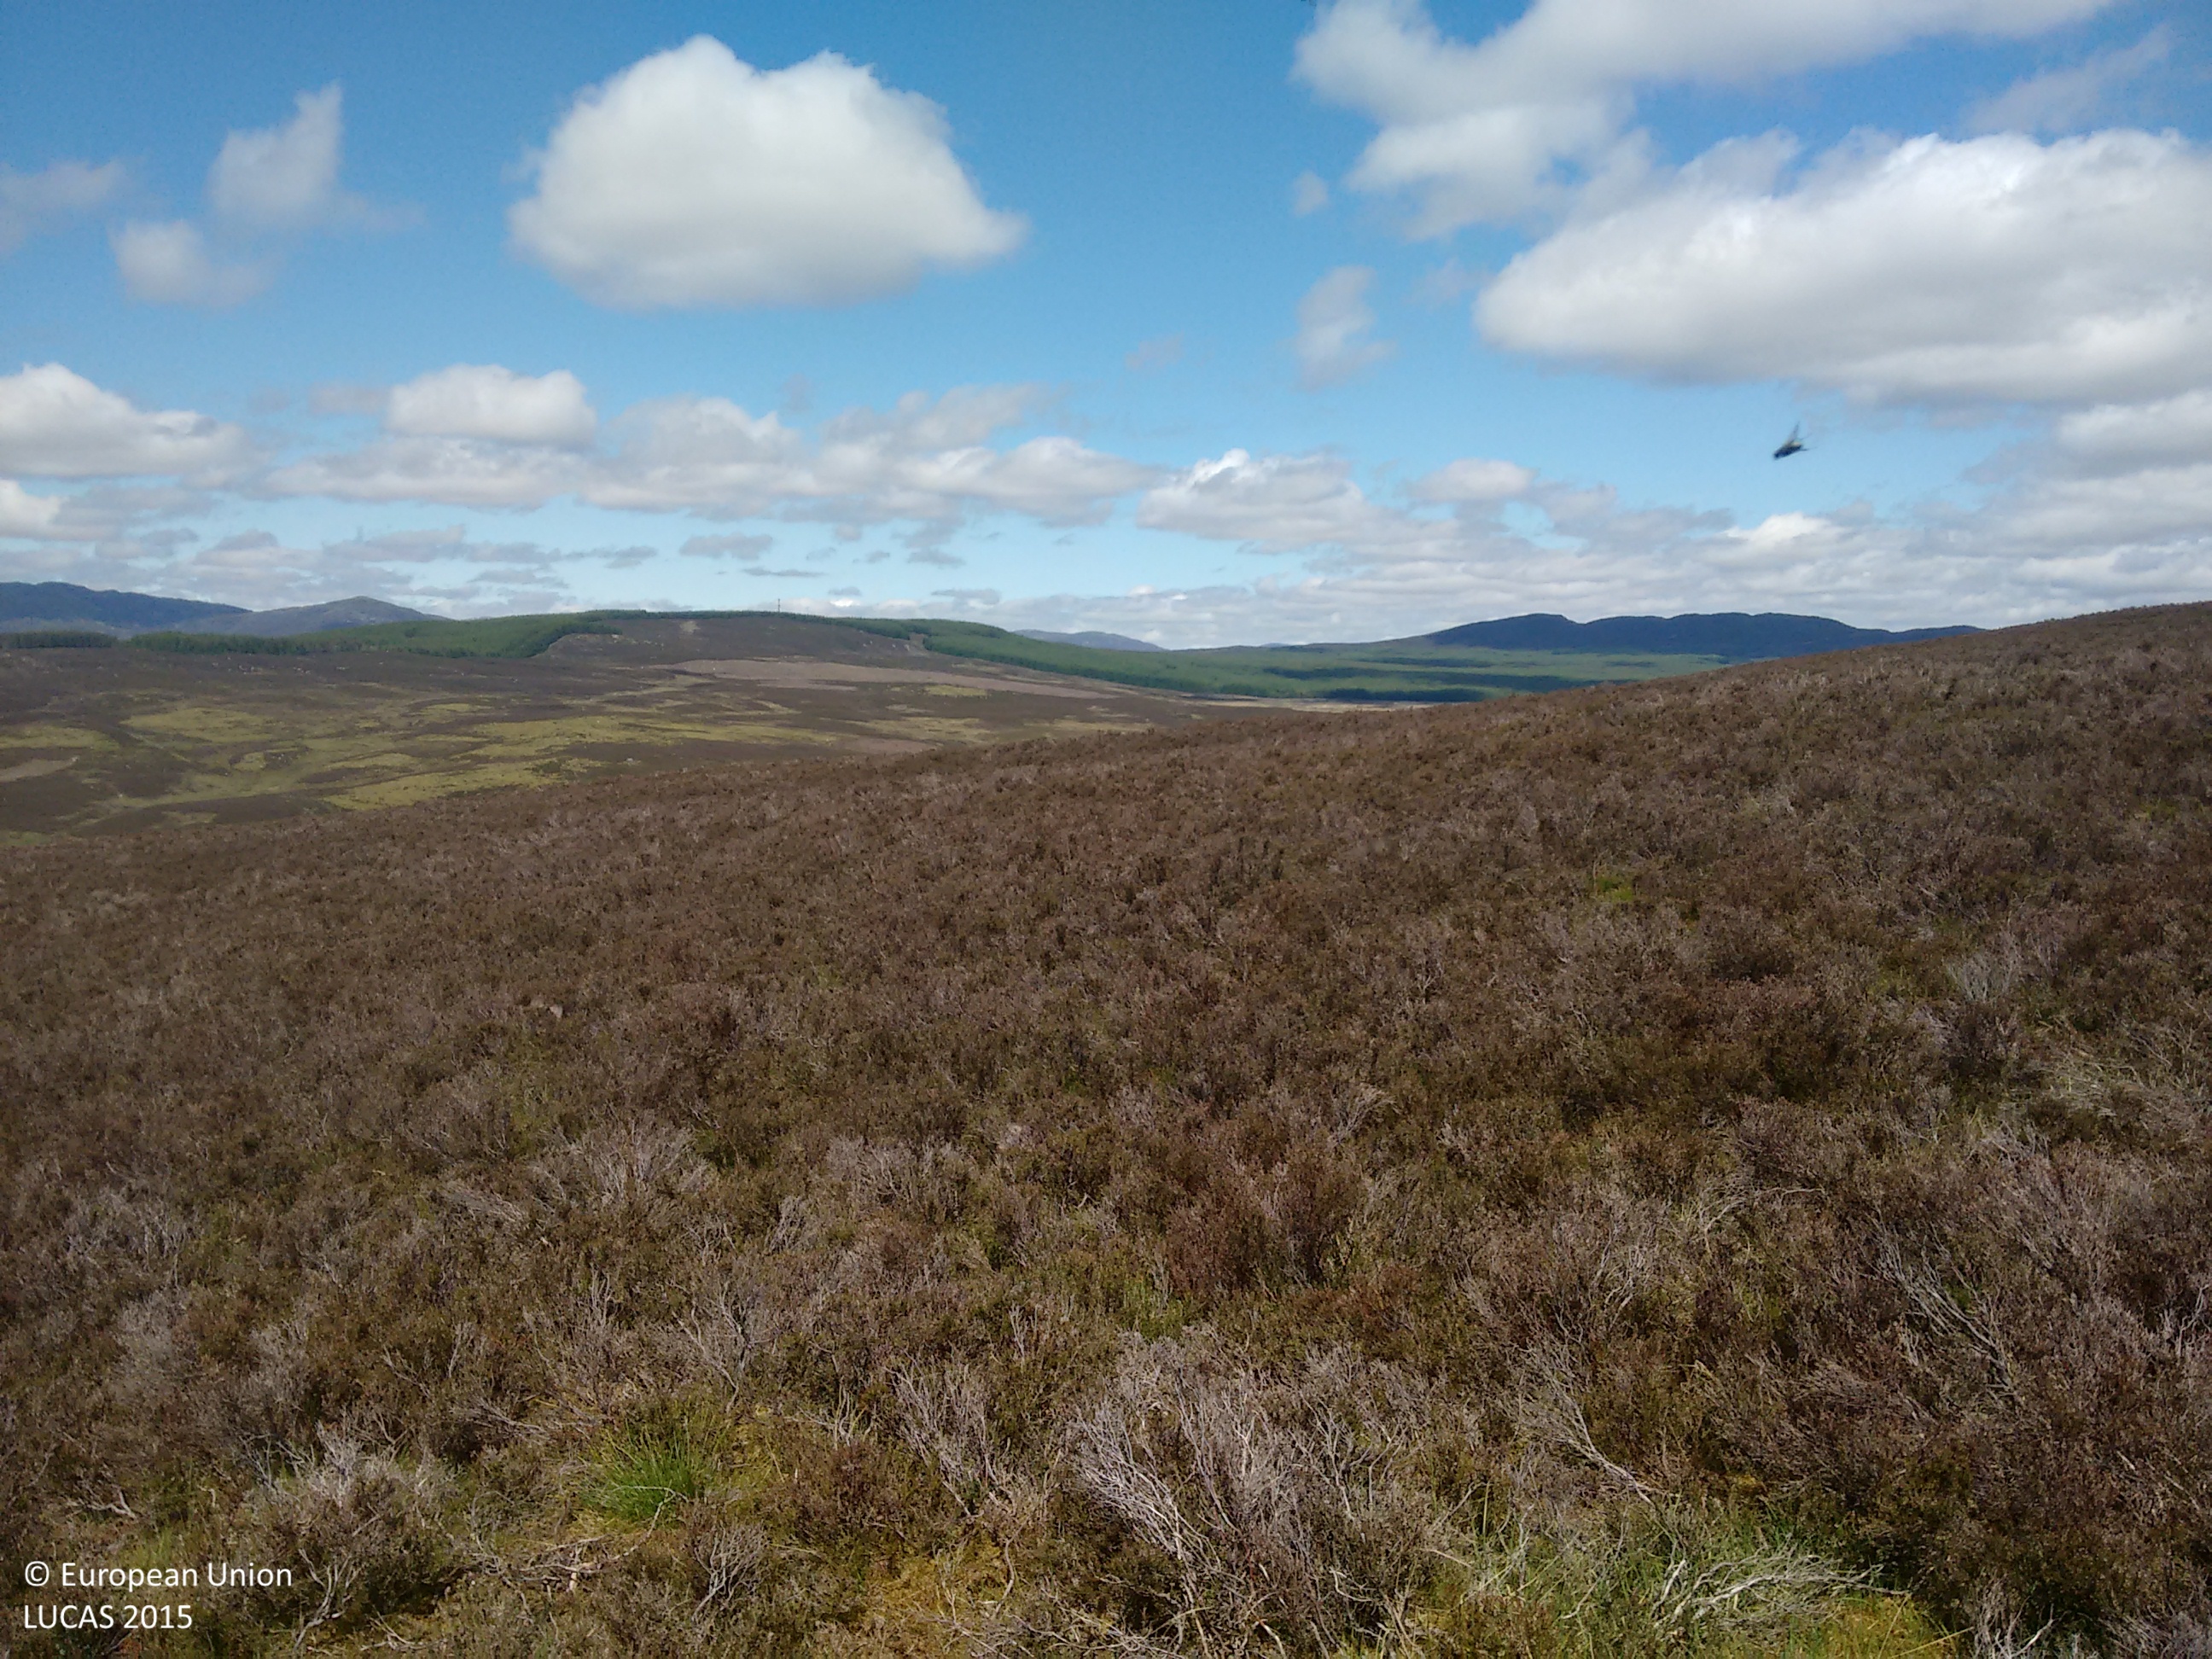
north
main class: Shrubland
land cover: Shrubland without tree cover
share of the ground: > 75 %
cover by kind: shrubs 90 %, herbaceous plants 10 %
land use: Semi-natural and natural areas not in use
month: June
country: GB
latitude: 56.6787
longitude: -3.6408
